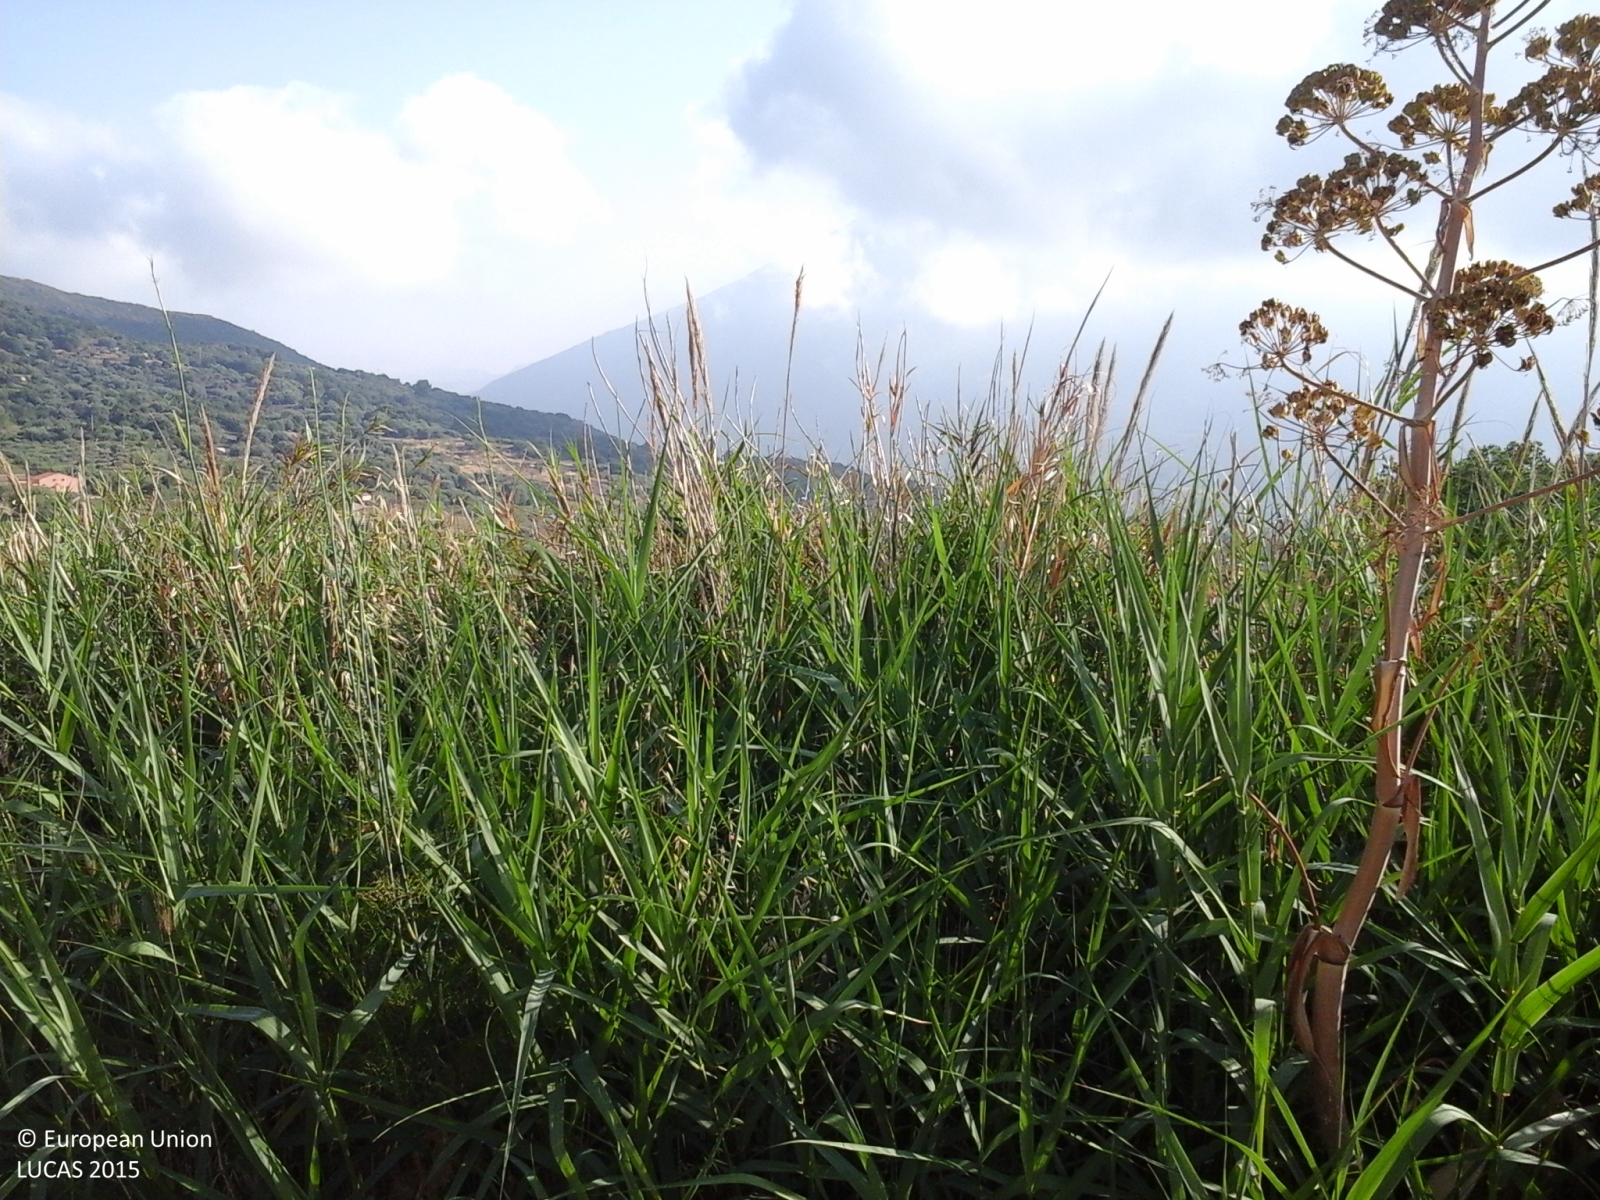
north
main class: Grassland
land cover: Spontaneously vegetated surfaces
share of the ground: > 75 %
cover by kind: herbaceous plants 100 %
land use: Fallow land
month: June
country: IT
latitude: 37.8124
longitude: 13.9135
